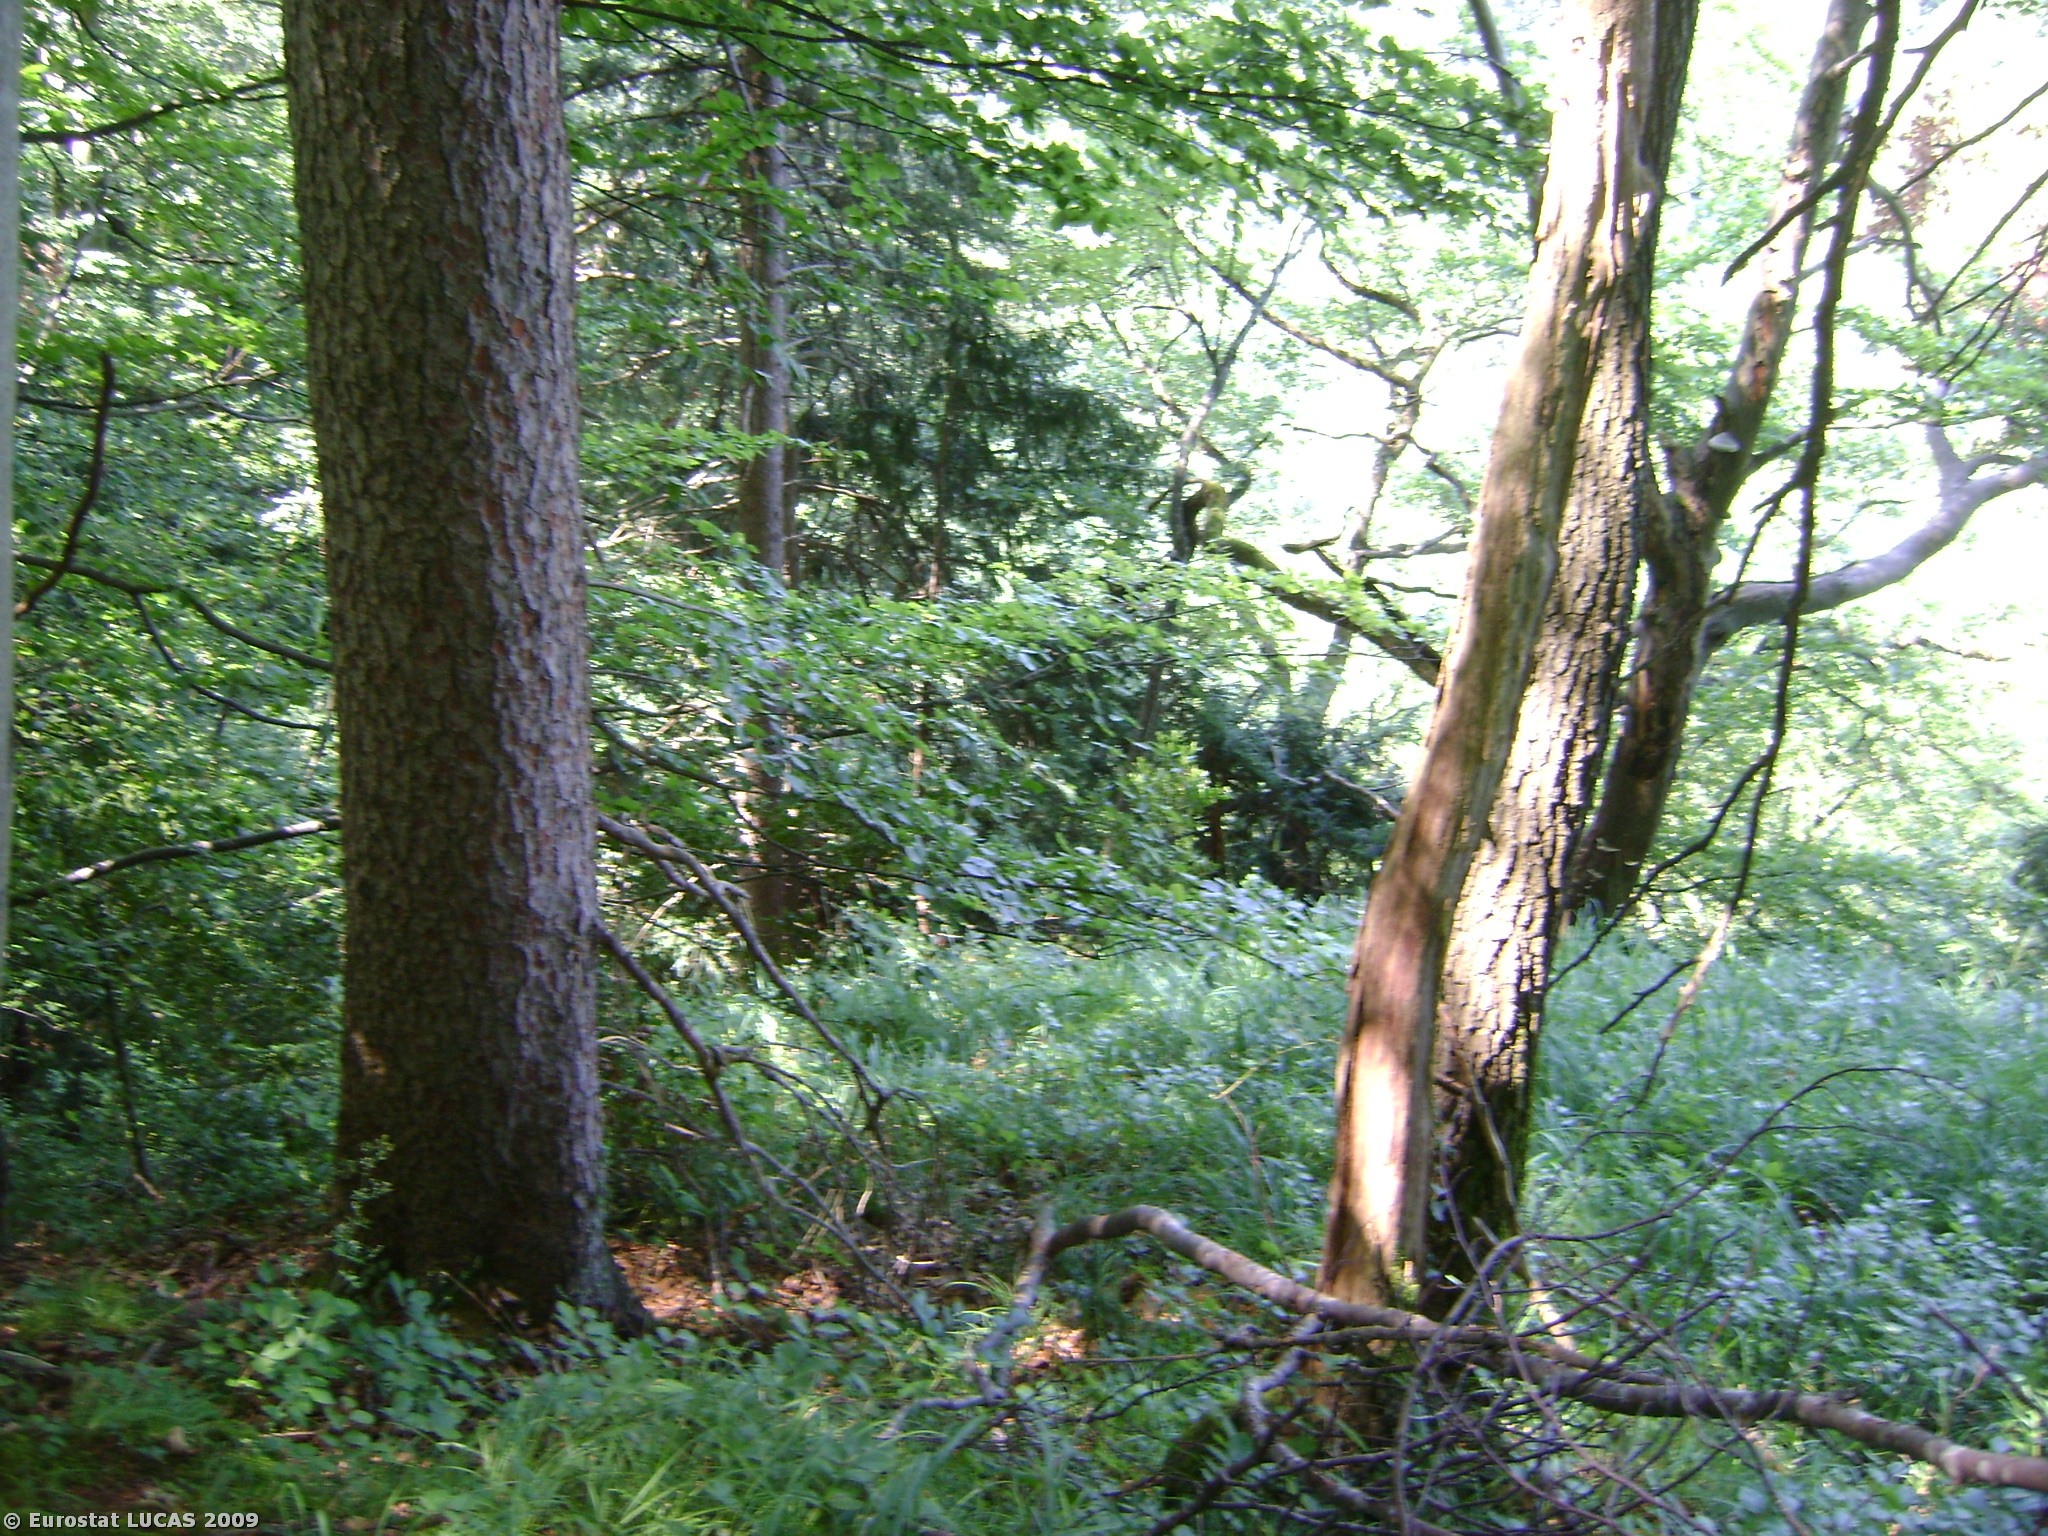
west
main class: Woodland
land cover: Broadleaved woodland
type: beech forest
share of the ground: > 75 %
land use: Forestry
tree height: > 5 m
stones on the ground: < 10 %
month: July
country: AT
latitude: 47.3411
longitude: 9.6694
